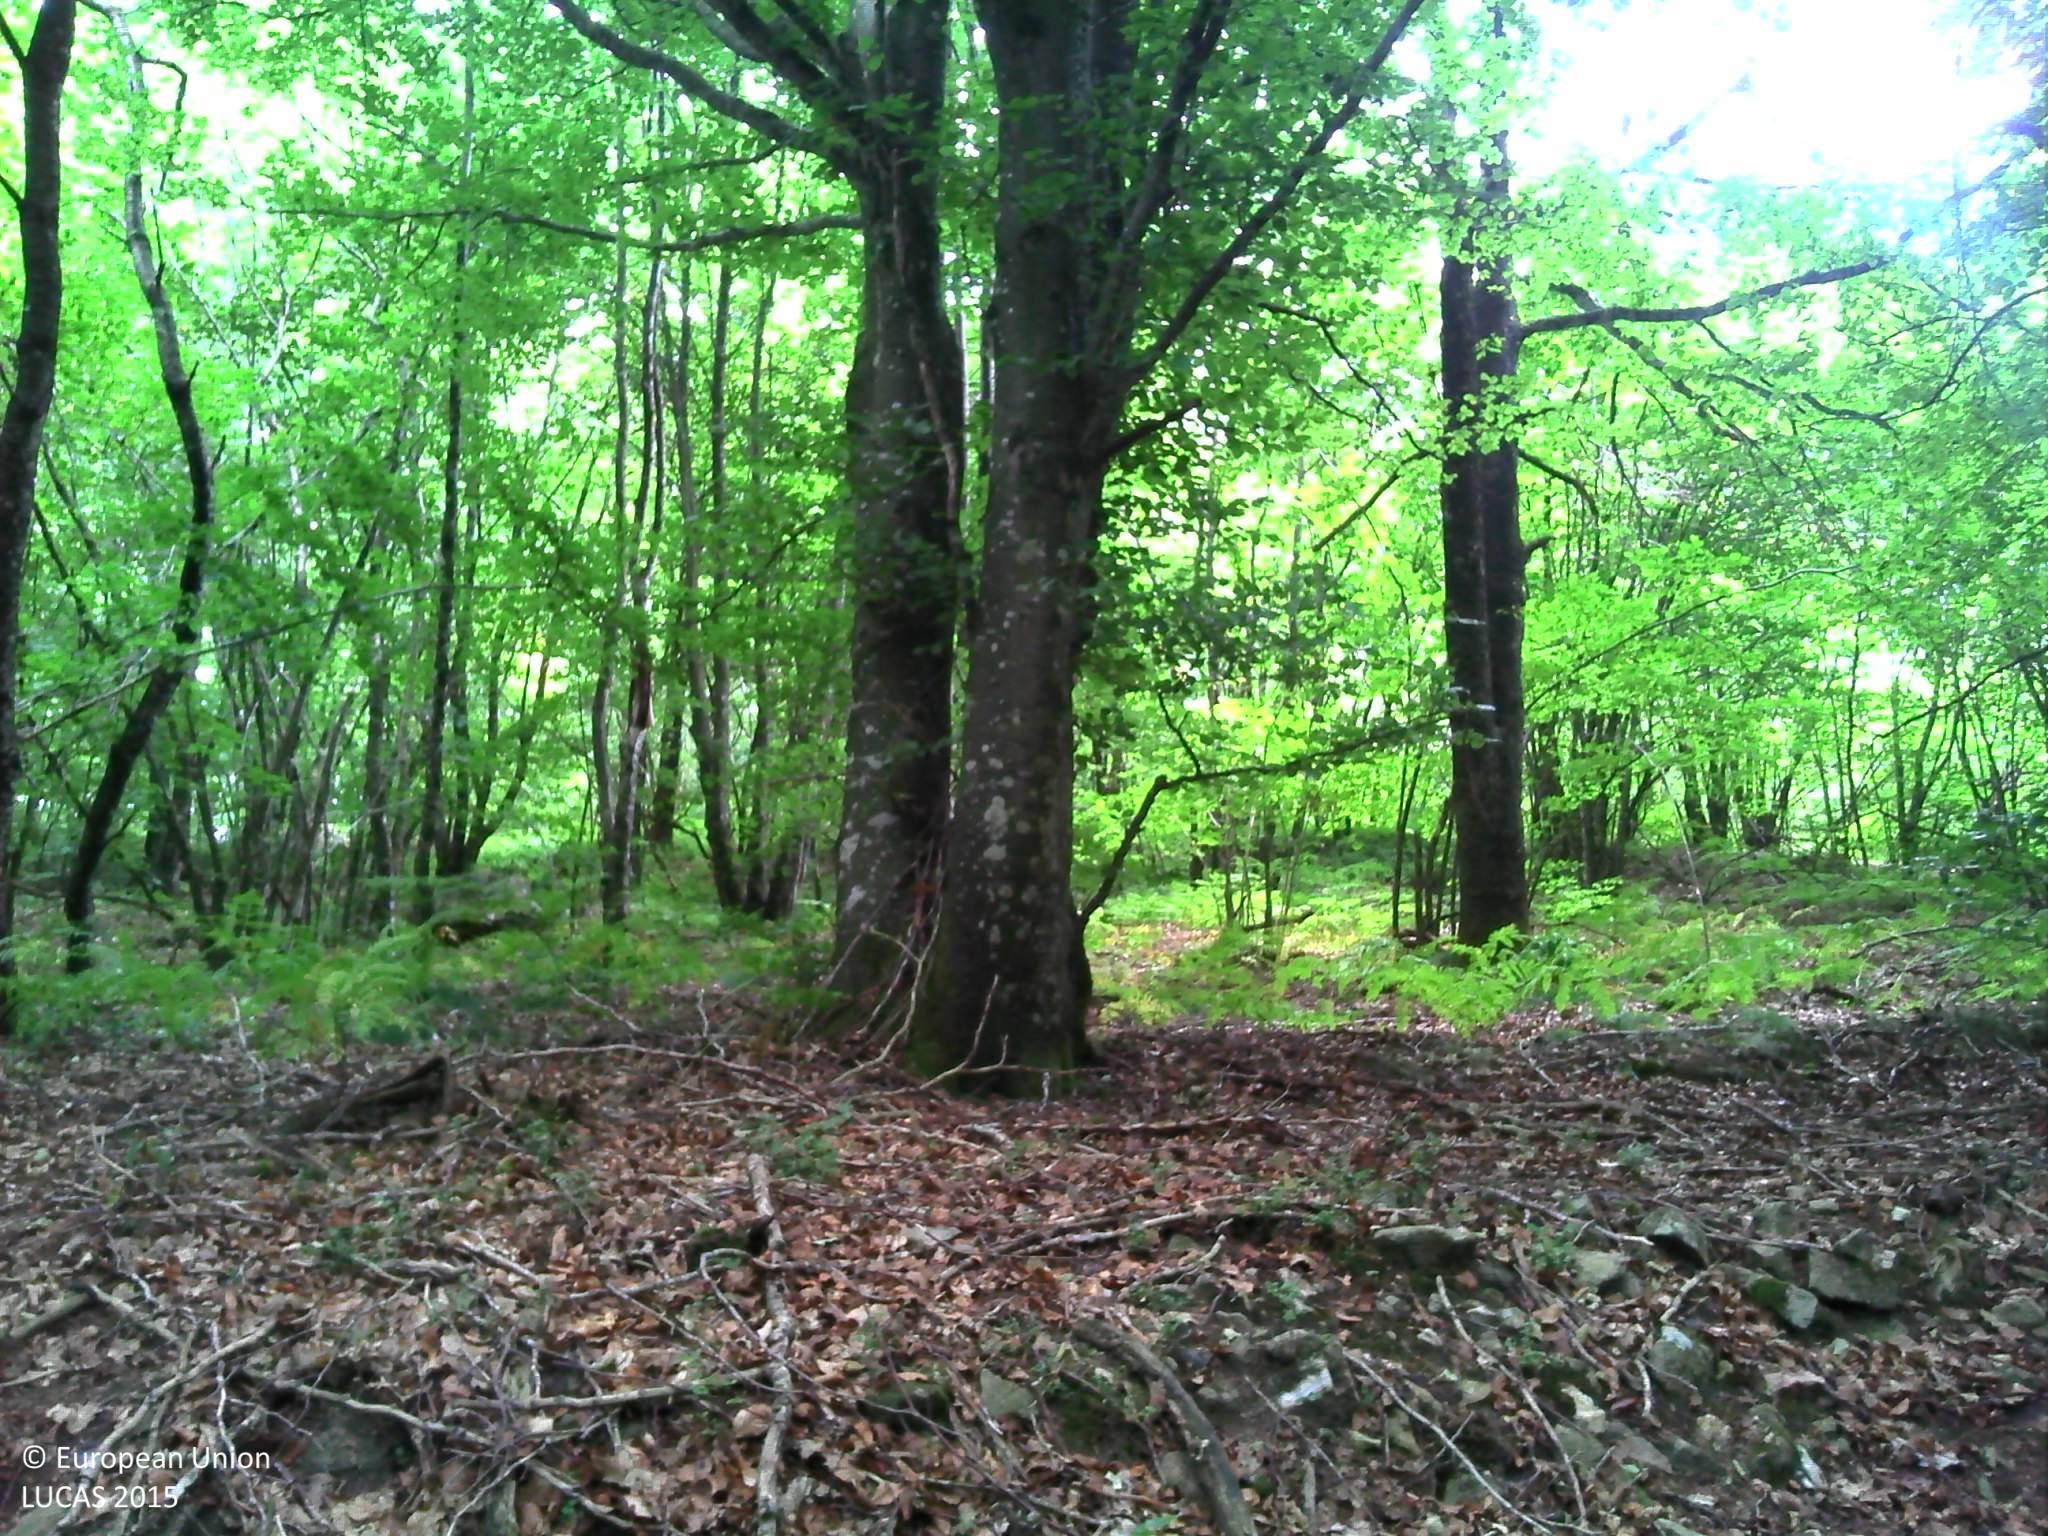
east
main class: Woodland
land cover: Broadleaved woodland
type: beech forest
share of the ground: > 75 %
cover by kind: broadleaved forest trees 80 %, unconsolidated bare surface 20 %
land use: Forestry
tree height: > 5 m
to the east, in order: Broadleaved woodland; Tracks; Broadleaved woodland; Tracks; Broadleaved woodland; Dry stone walls; Broadleaved woodland; Ditches and canals; Broadleaved woodland
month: July
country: FR
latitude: 43.6913
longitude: 2.6494
